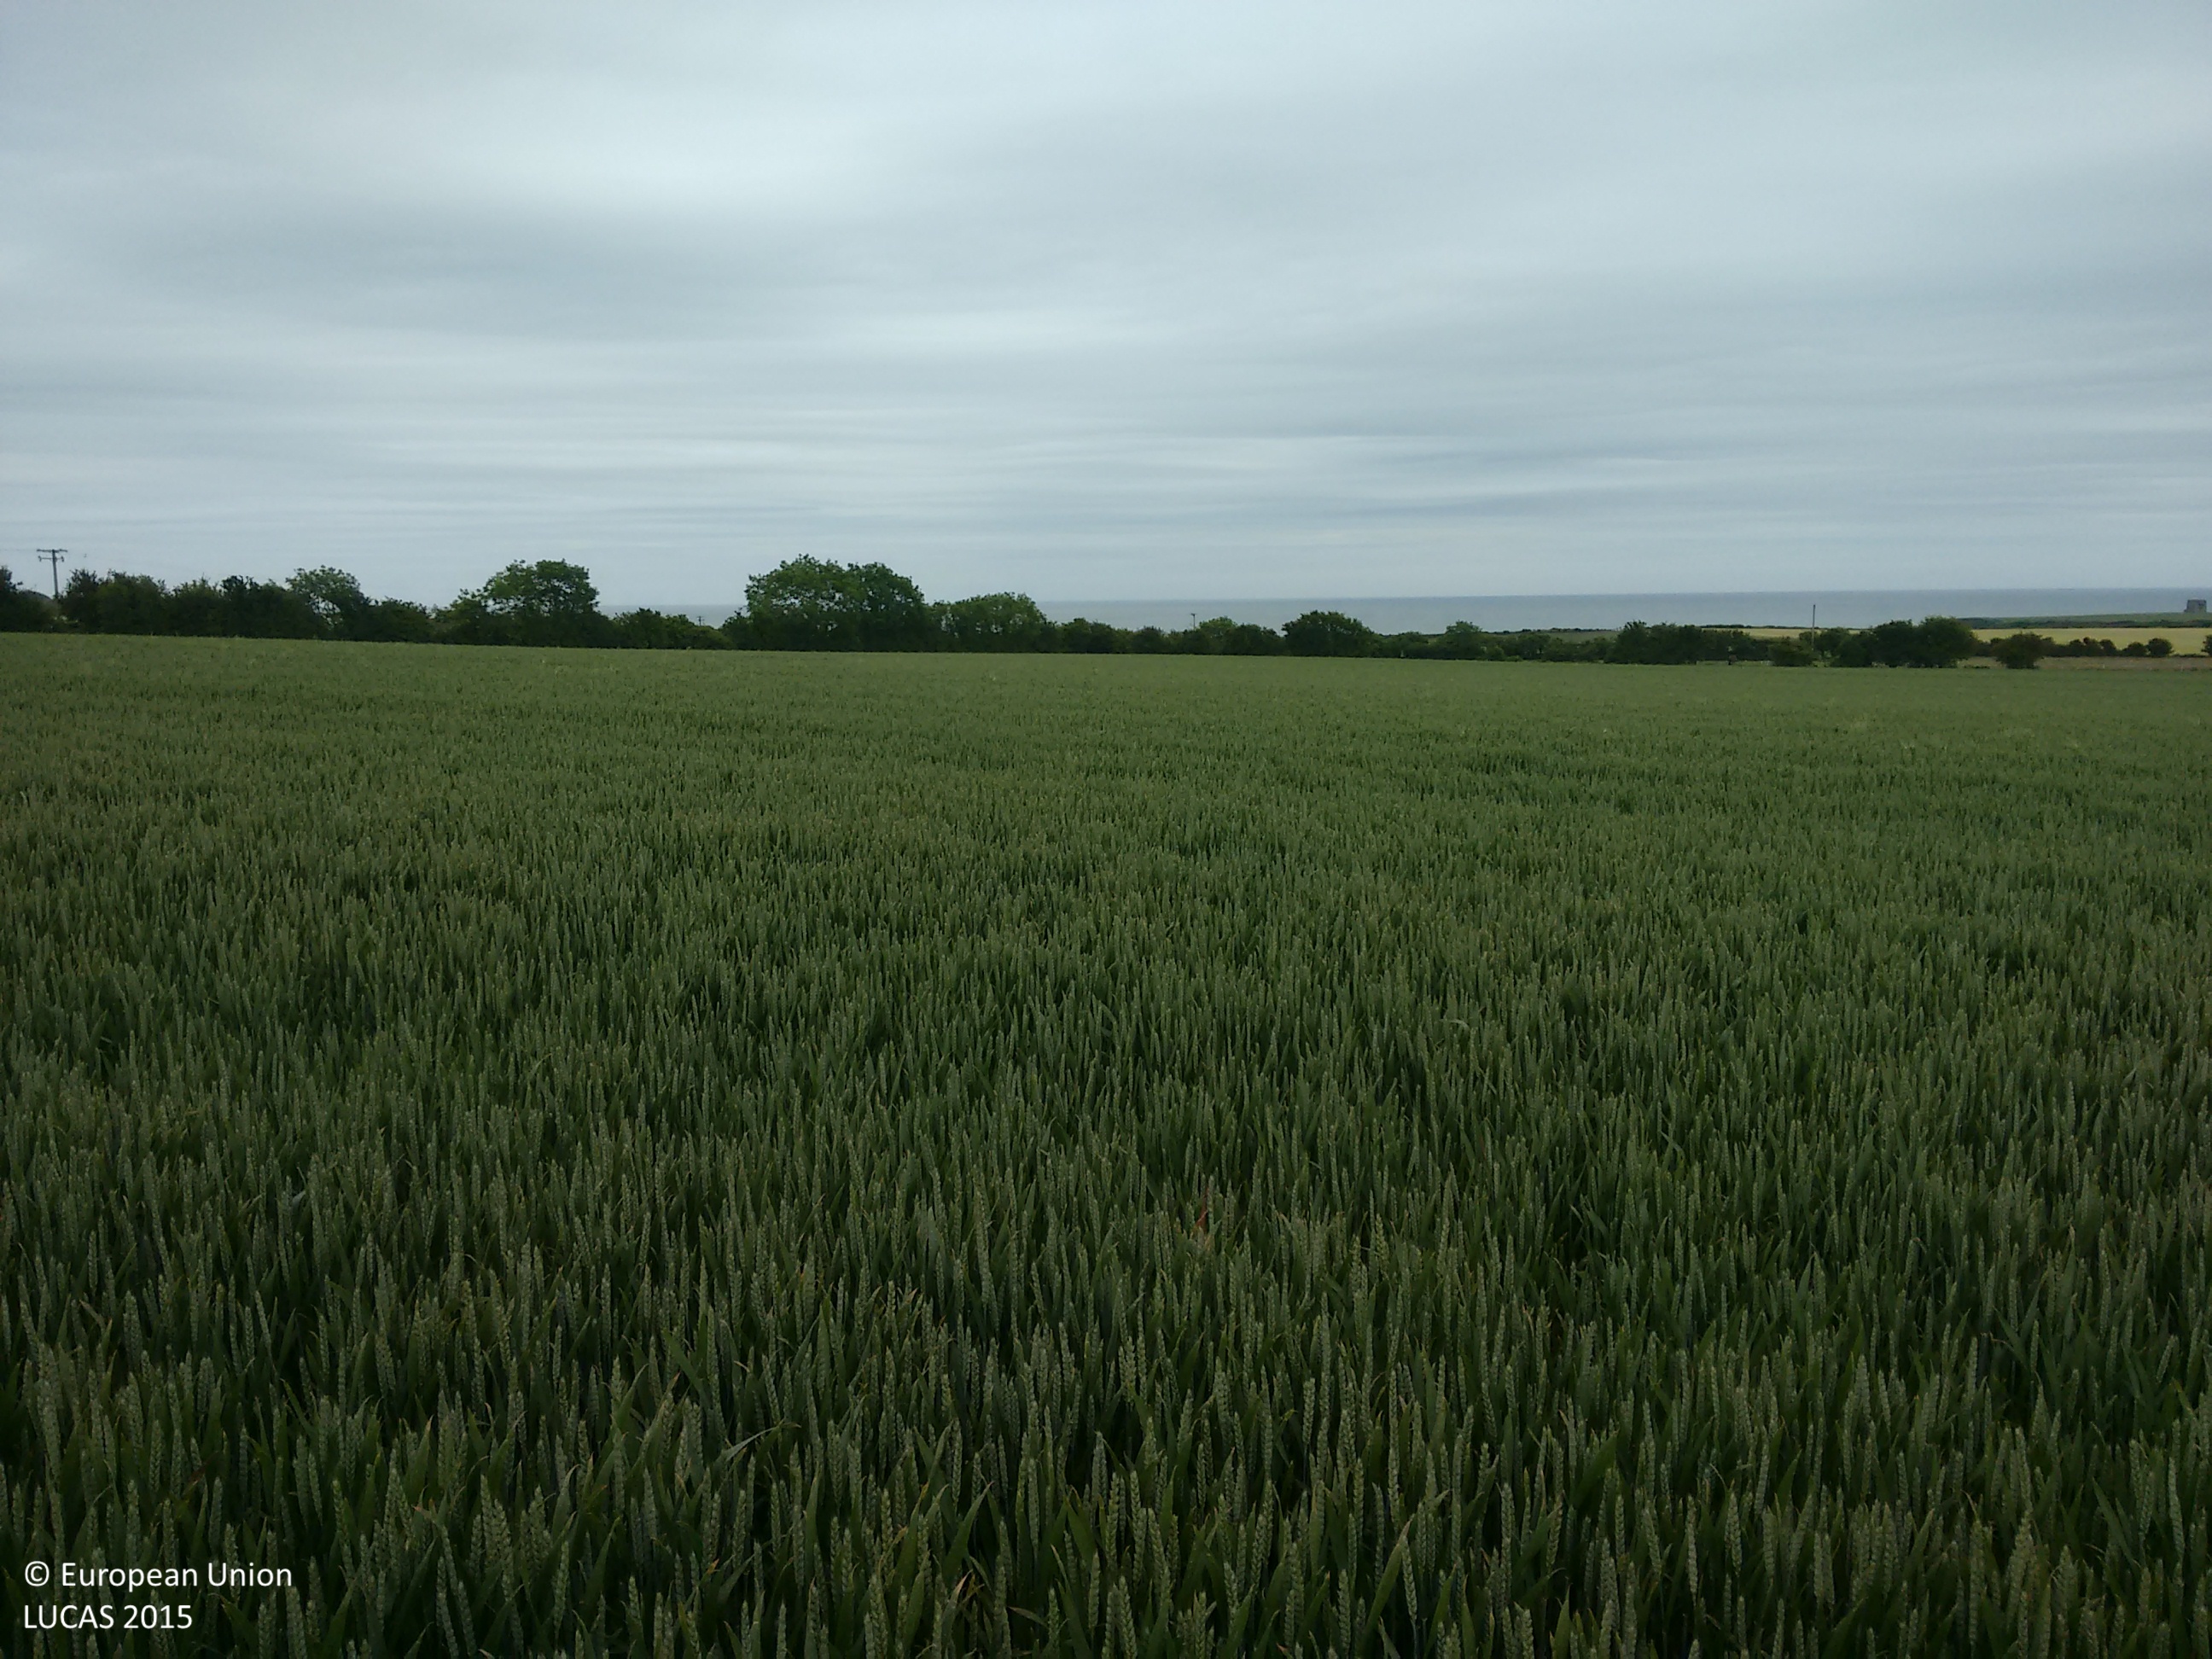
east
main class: Cropland
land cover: Barley
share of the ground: > 75 %
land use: Agriculture (excluding fallow land and kitchen gardens)
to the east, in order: Barley; Abandoned hedges; Grassland without tree/shrub cover
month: June
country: IE
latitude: 53.5448
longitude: -6.0967
